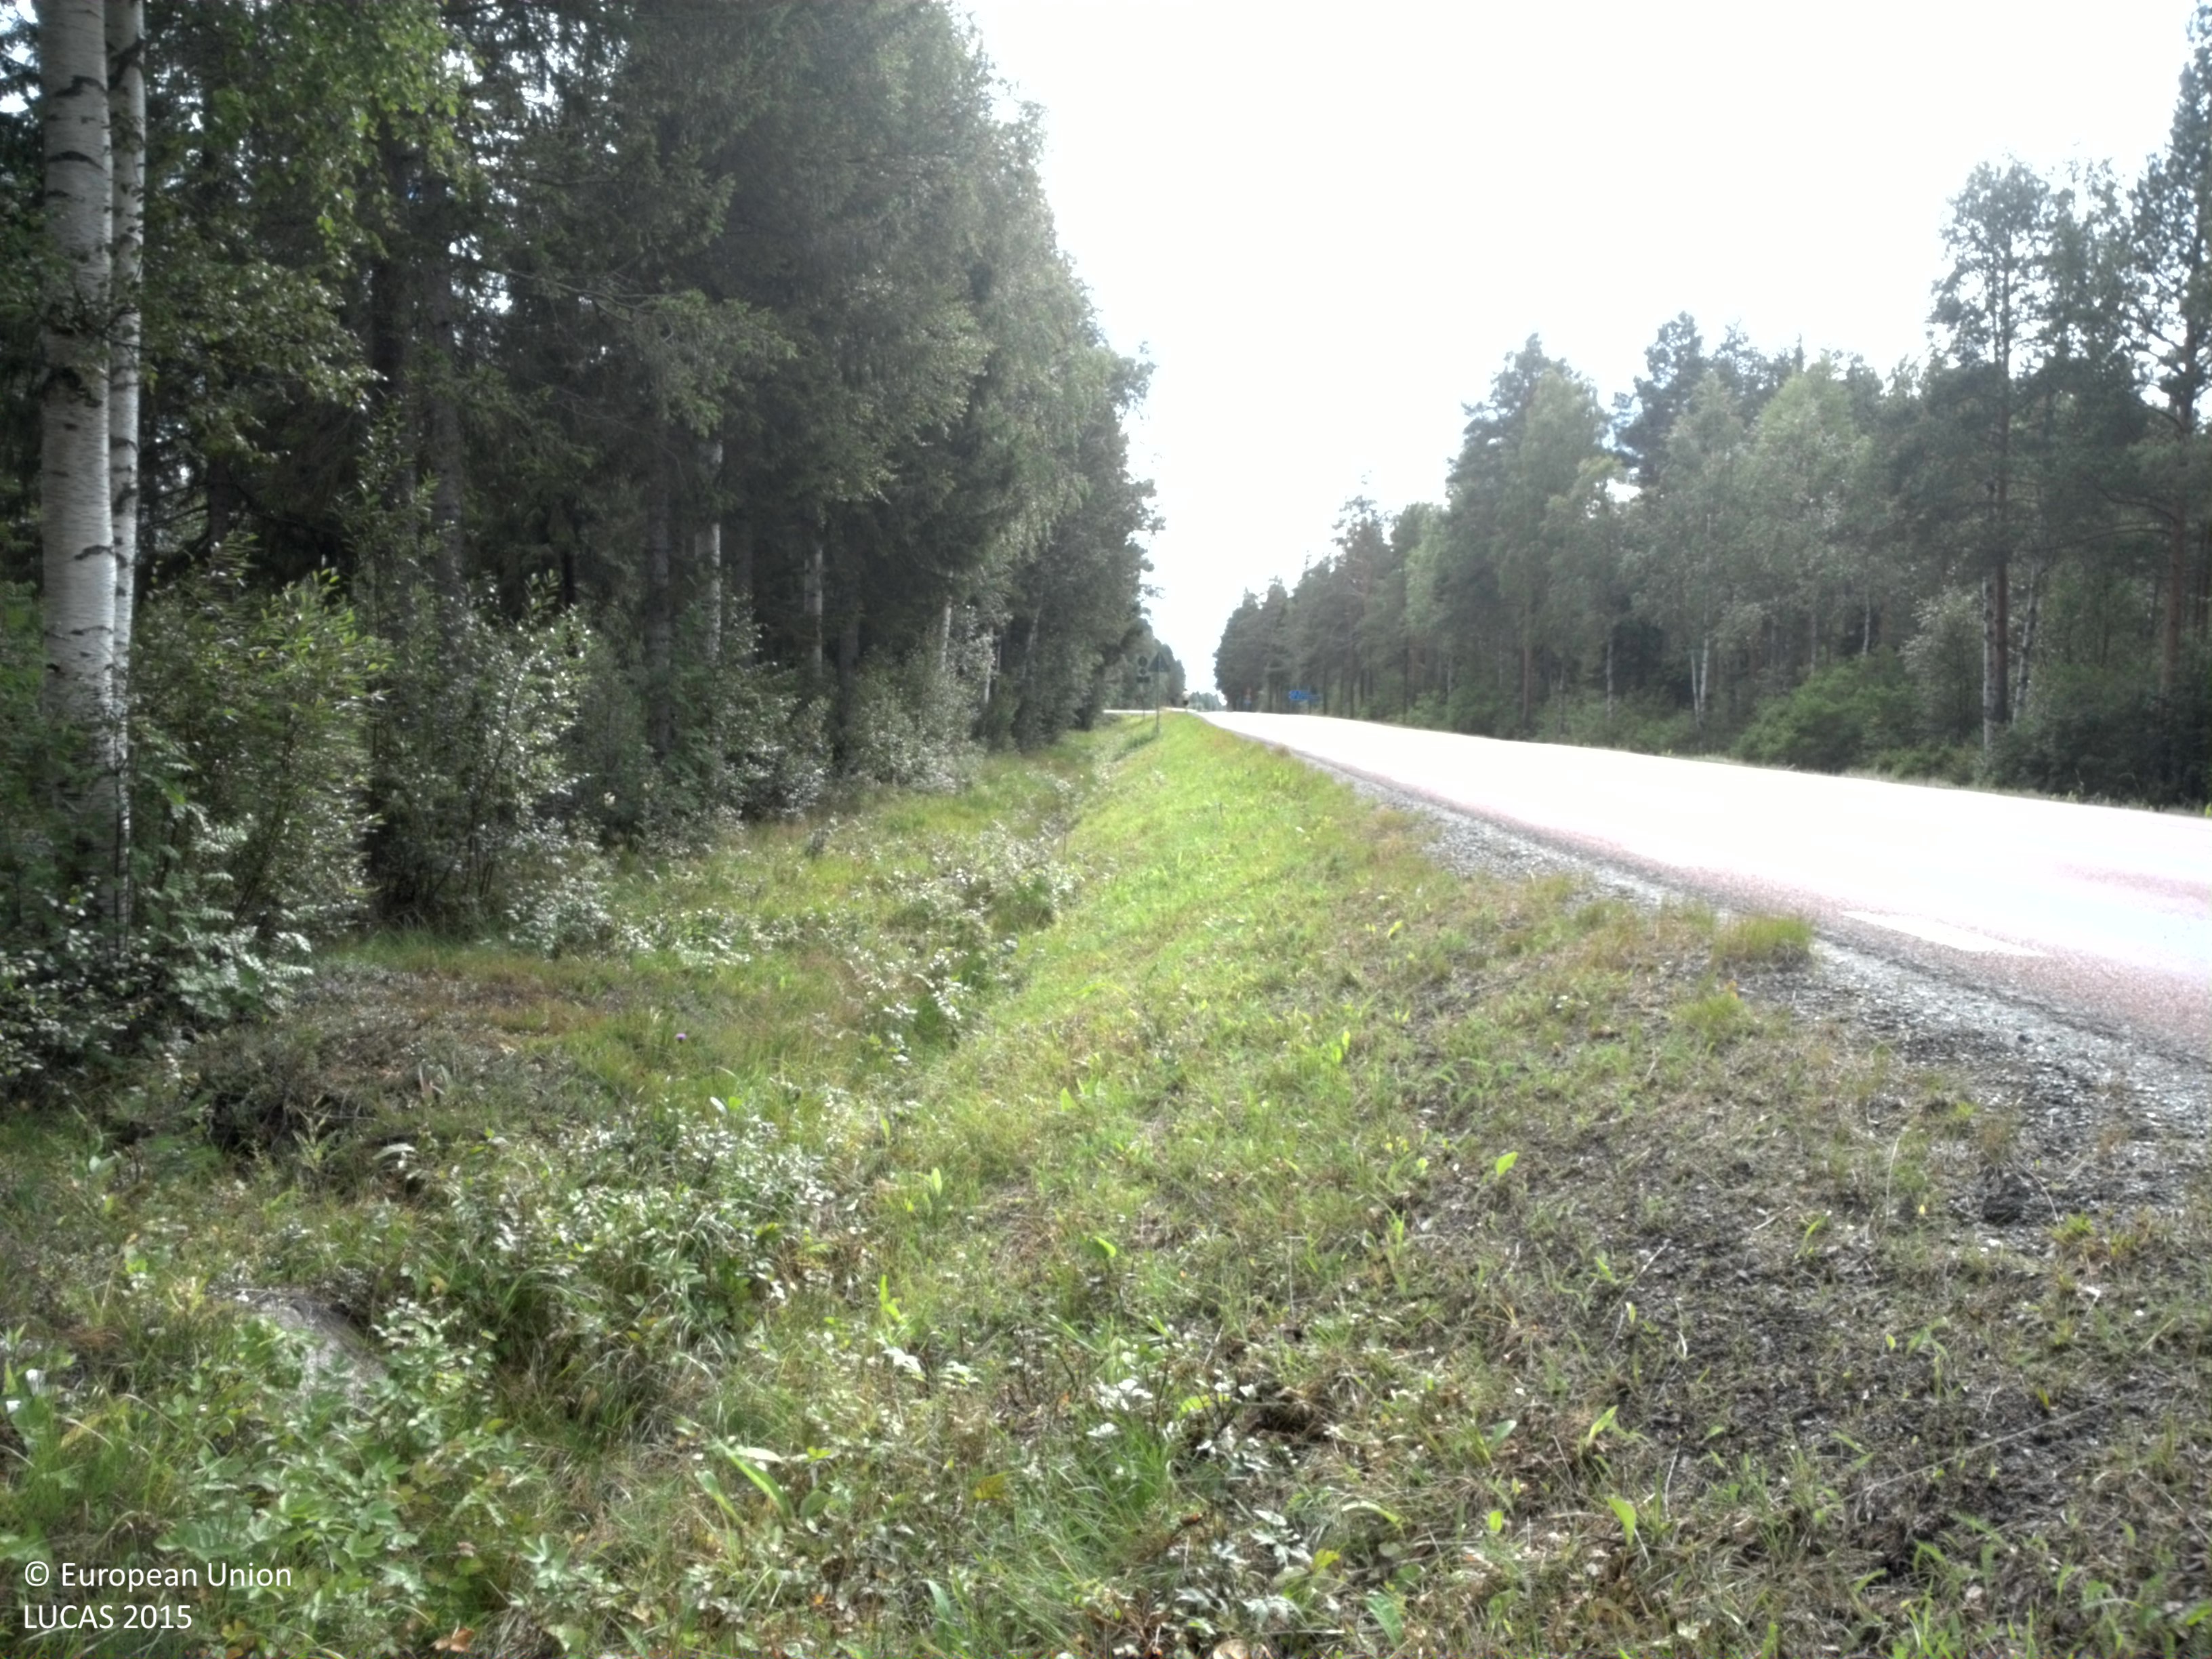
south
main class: Woodland
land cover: Spruce dominated mixed woodland
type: boreal forest
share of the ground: 50 - 75 %
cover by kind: coniferous forest trees 45 %, shrubs 25 %, broadleaved forest trees 15 %, herbaceous plants 10 %, lichens and mosses 5 %
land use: Forestry
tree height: > 5 m
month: August
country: SE
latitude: 64.6207
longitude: 20.9575
